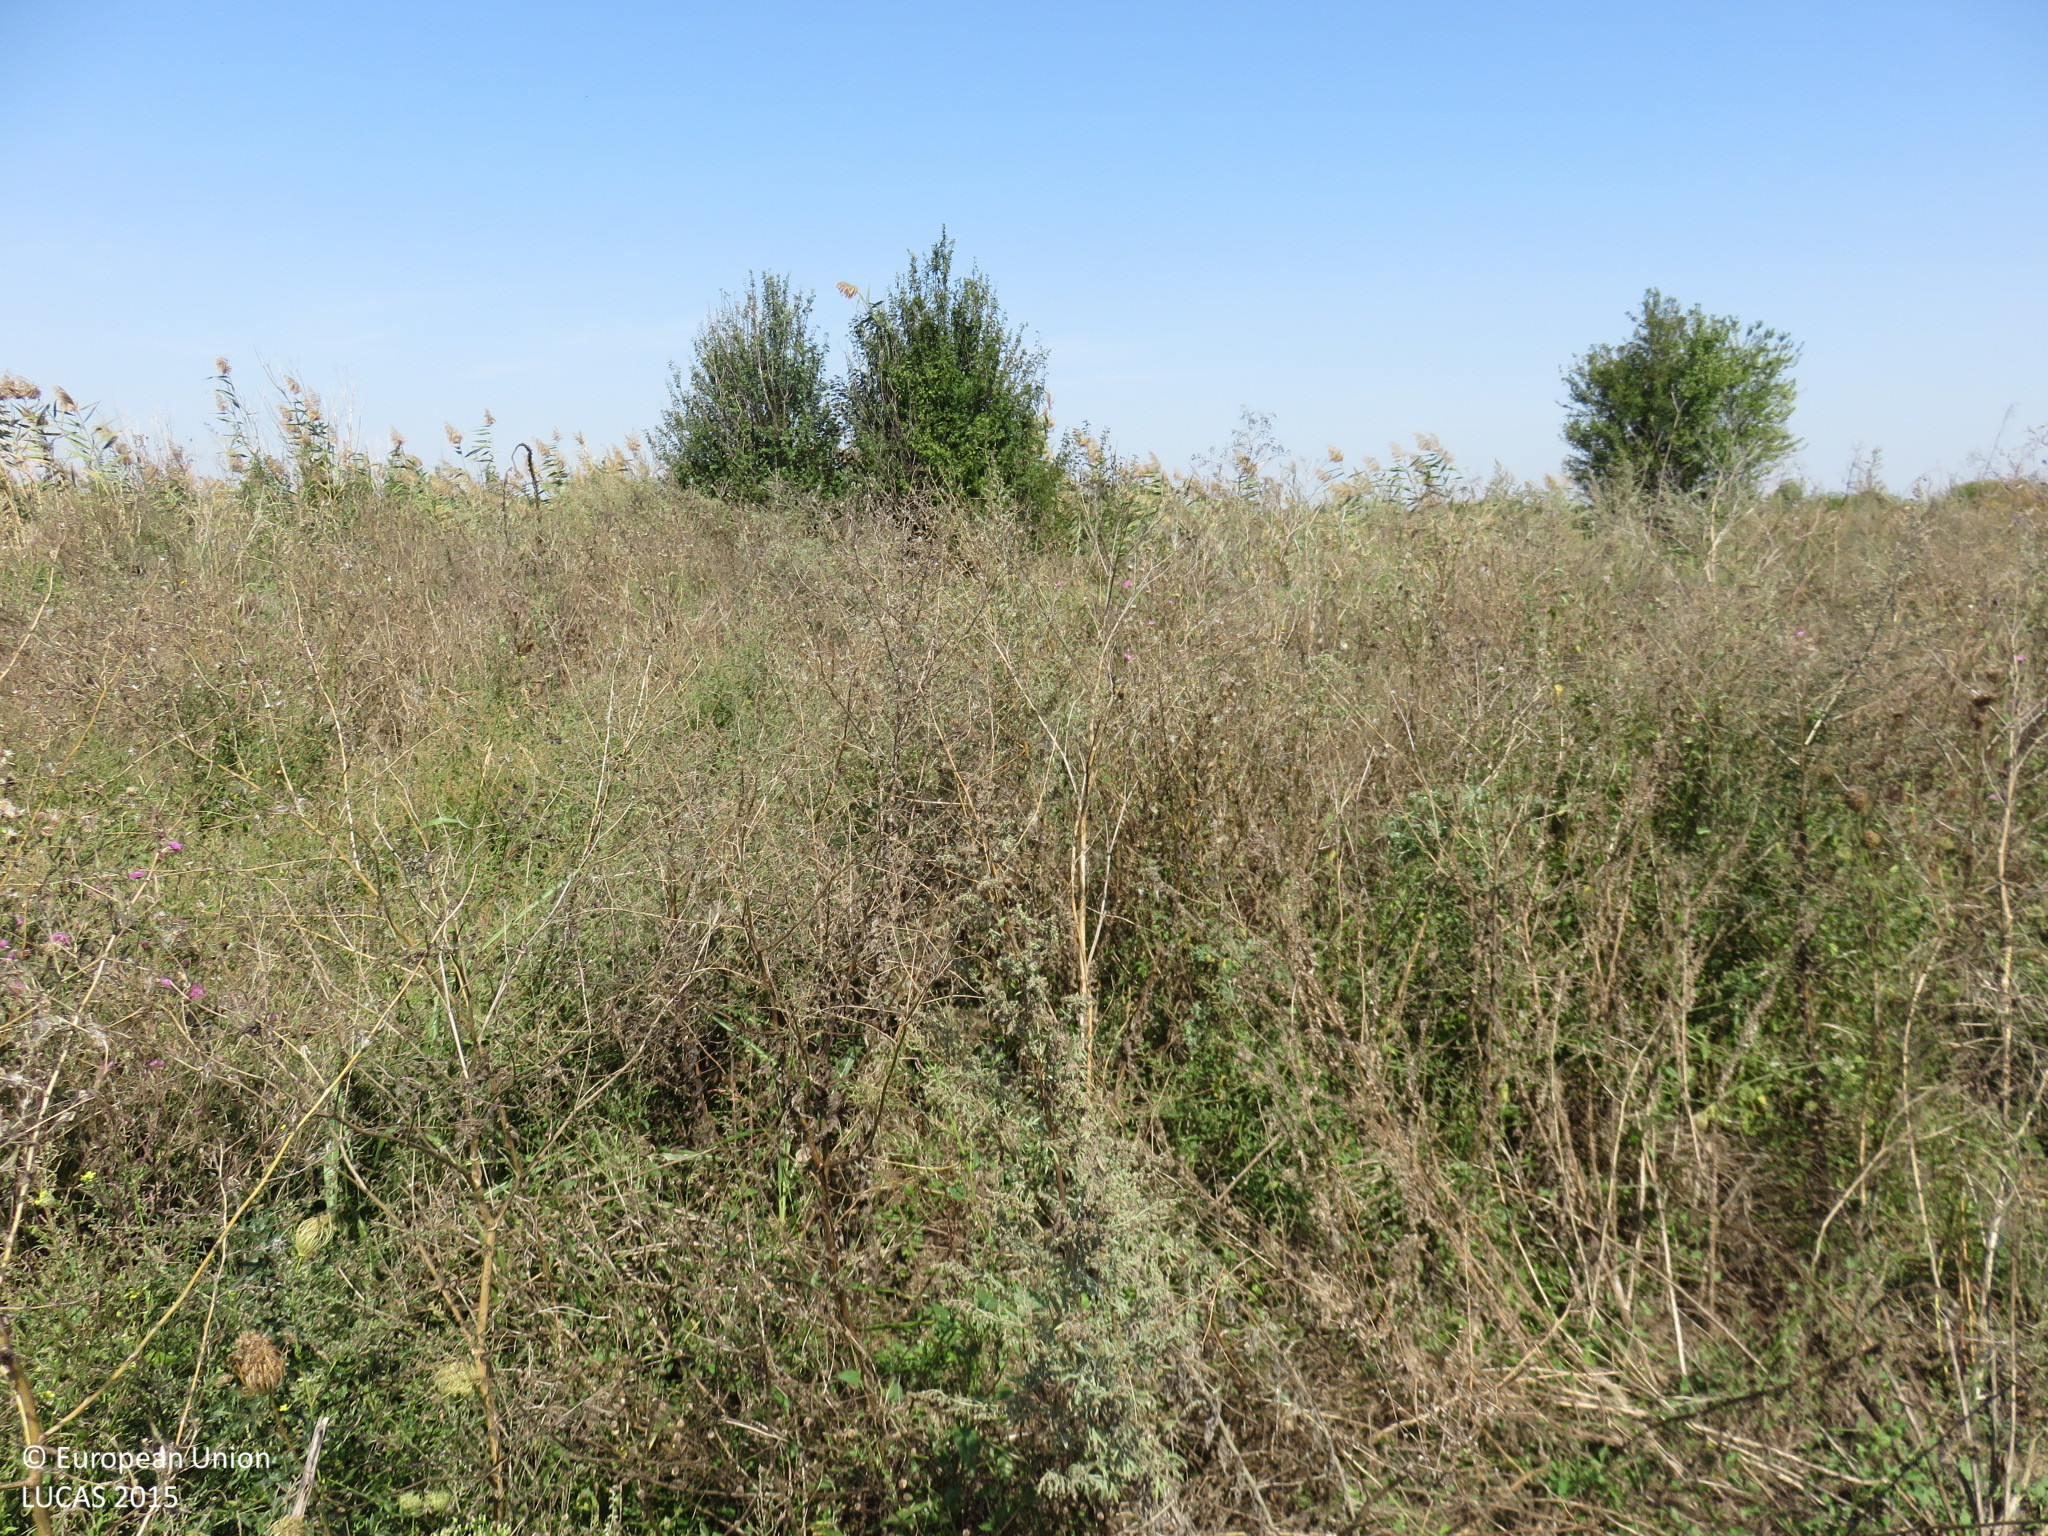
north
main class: Grassland
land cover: Spontaneously vegetated surfaces
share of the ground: > 75 %
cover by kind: herbaceous plants 100 %
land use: Agriculture (excluding fallow land and kitchen gardens)
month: September
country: BG
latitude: 43.7107
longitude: 24.6238
